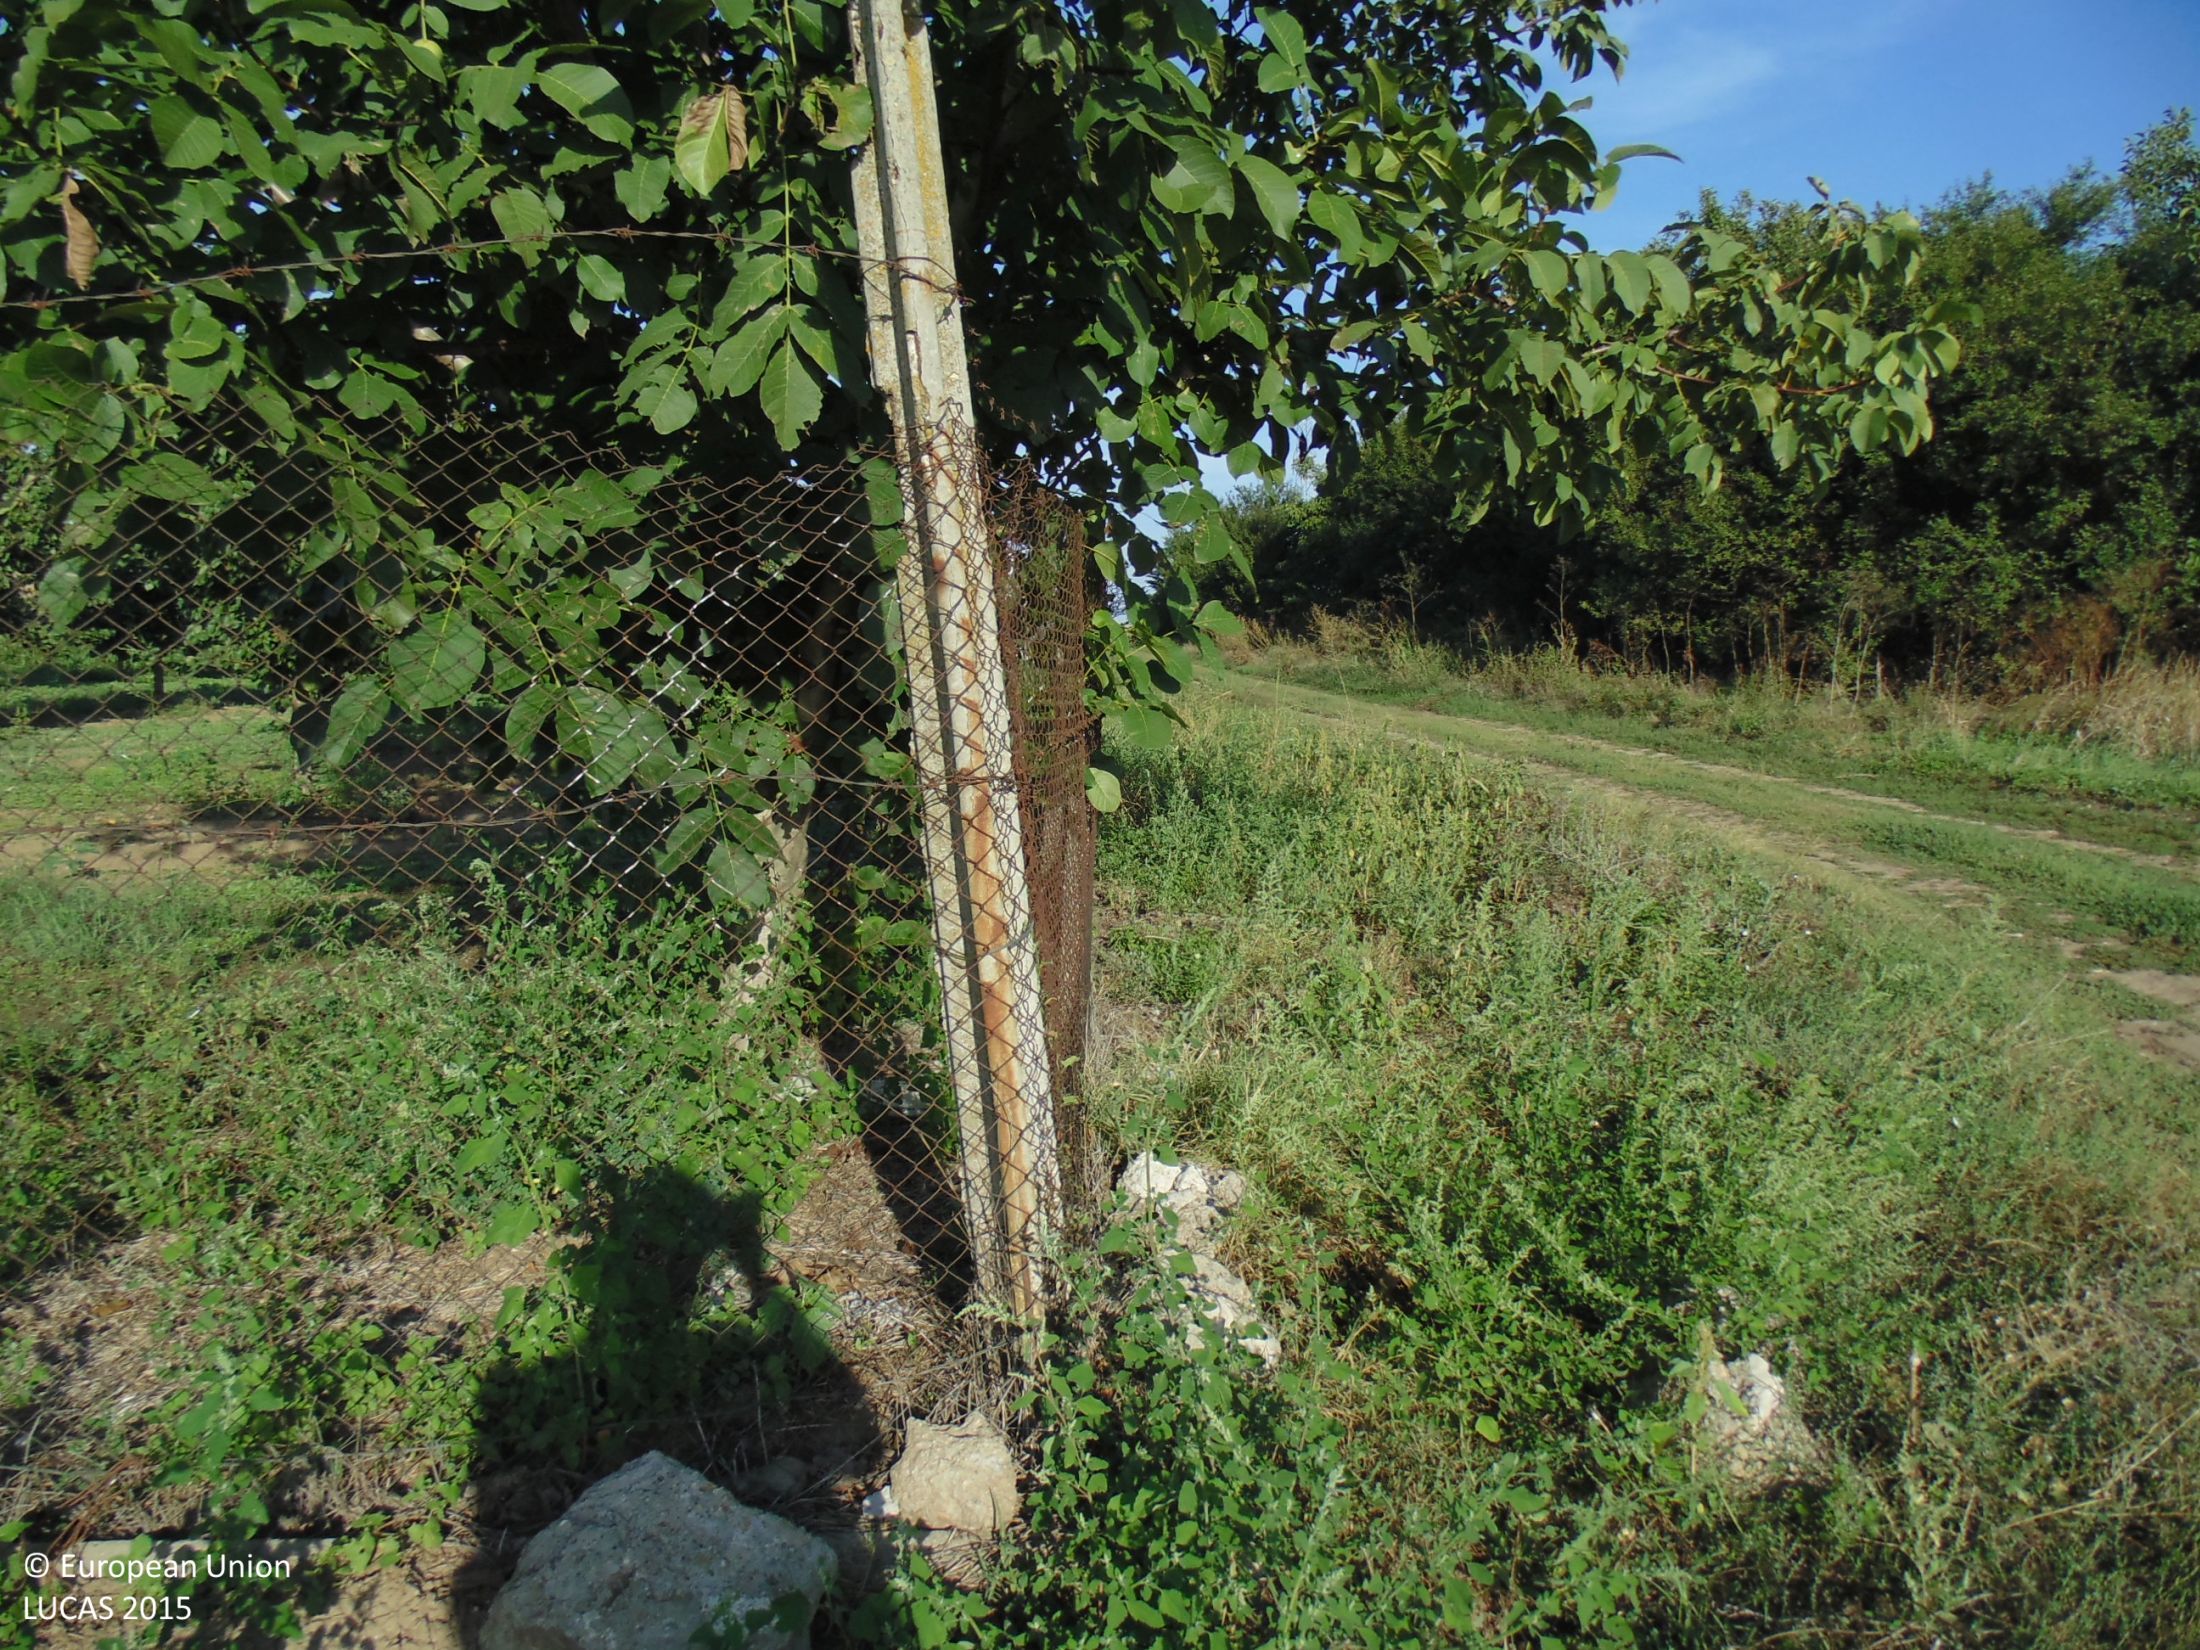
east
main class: Grassland
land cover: Grassland with sparse tree/shrub cover
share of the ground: > 75 %
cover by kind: herbaceous plants 95 %, broadleaved forest trees 5 %
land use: Semi-natural and natural areas not in use
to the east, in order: Grassland with sparse tree/shrub cover; Fences; Grassland with sparse tree/shrub cover; Fences; Grassland with sparse tree/shrub cover; Tracks; Grassland with sparse tree/shrub cover; Electric lines; Grassland with sparse tree/shrub cover; Tracks; Grass margins; Maize; Grass margins; Tracks; Spontaneously vegetated surfaces
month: September
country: BG
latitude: 44.0623
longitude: 26.8613
